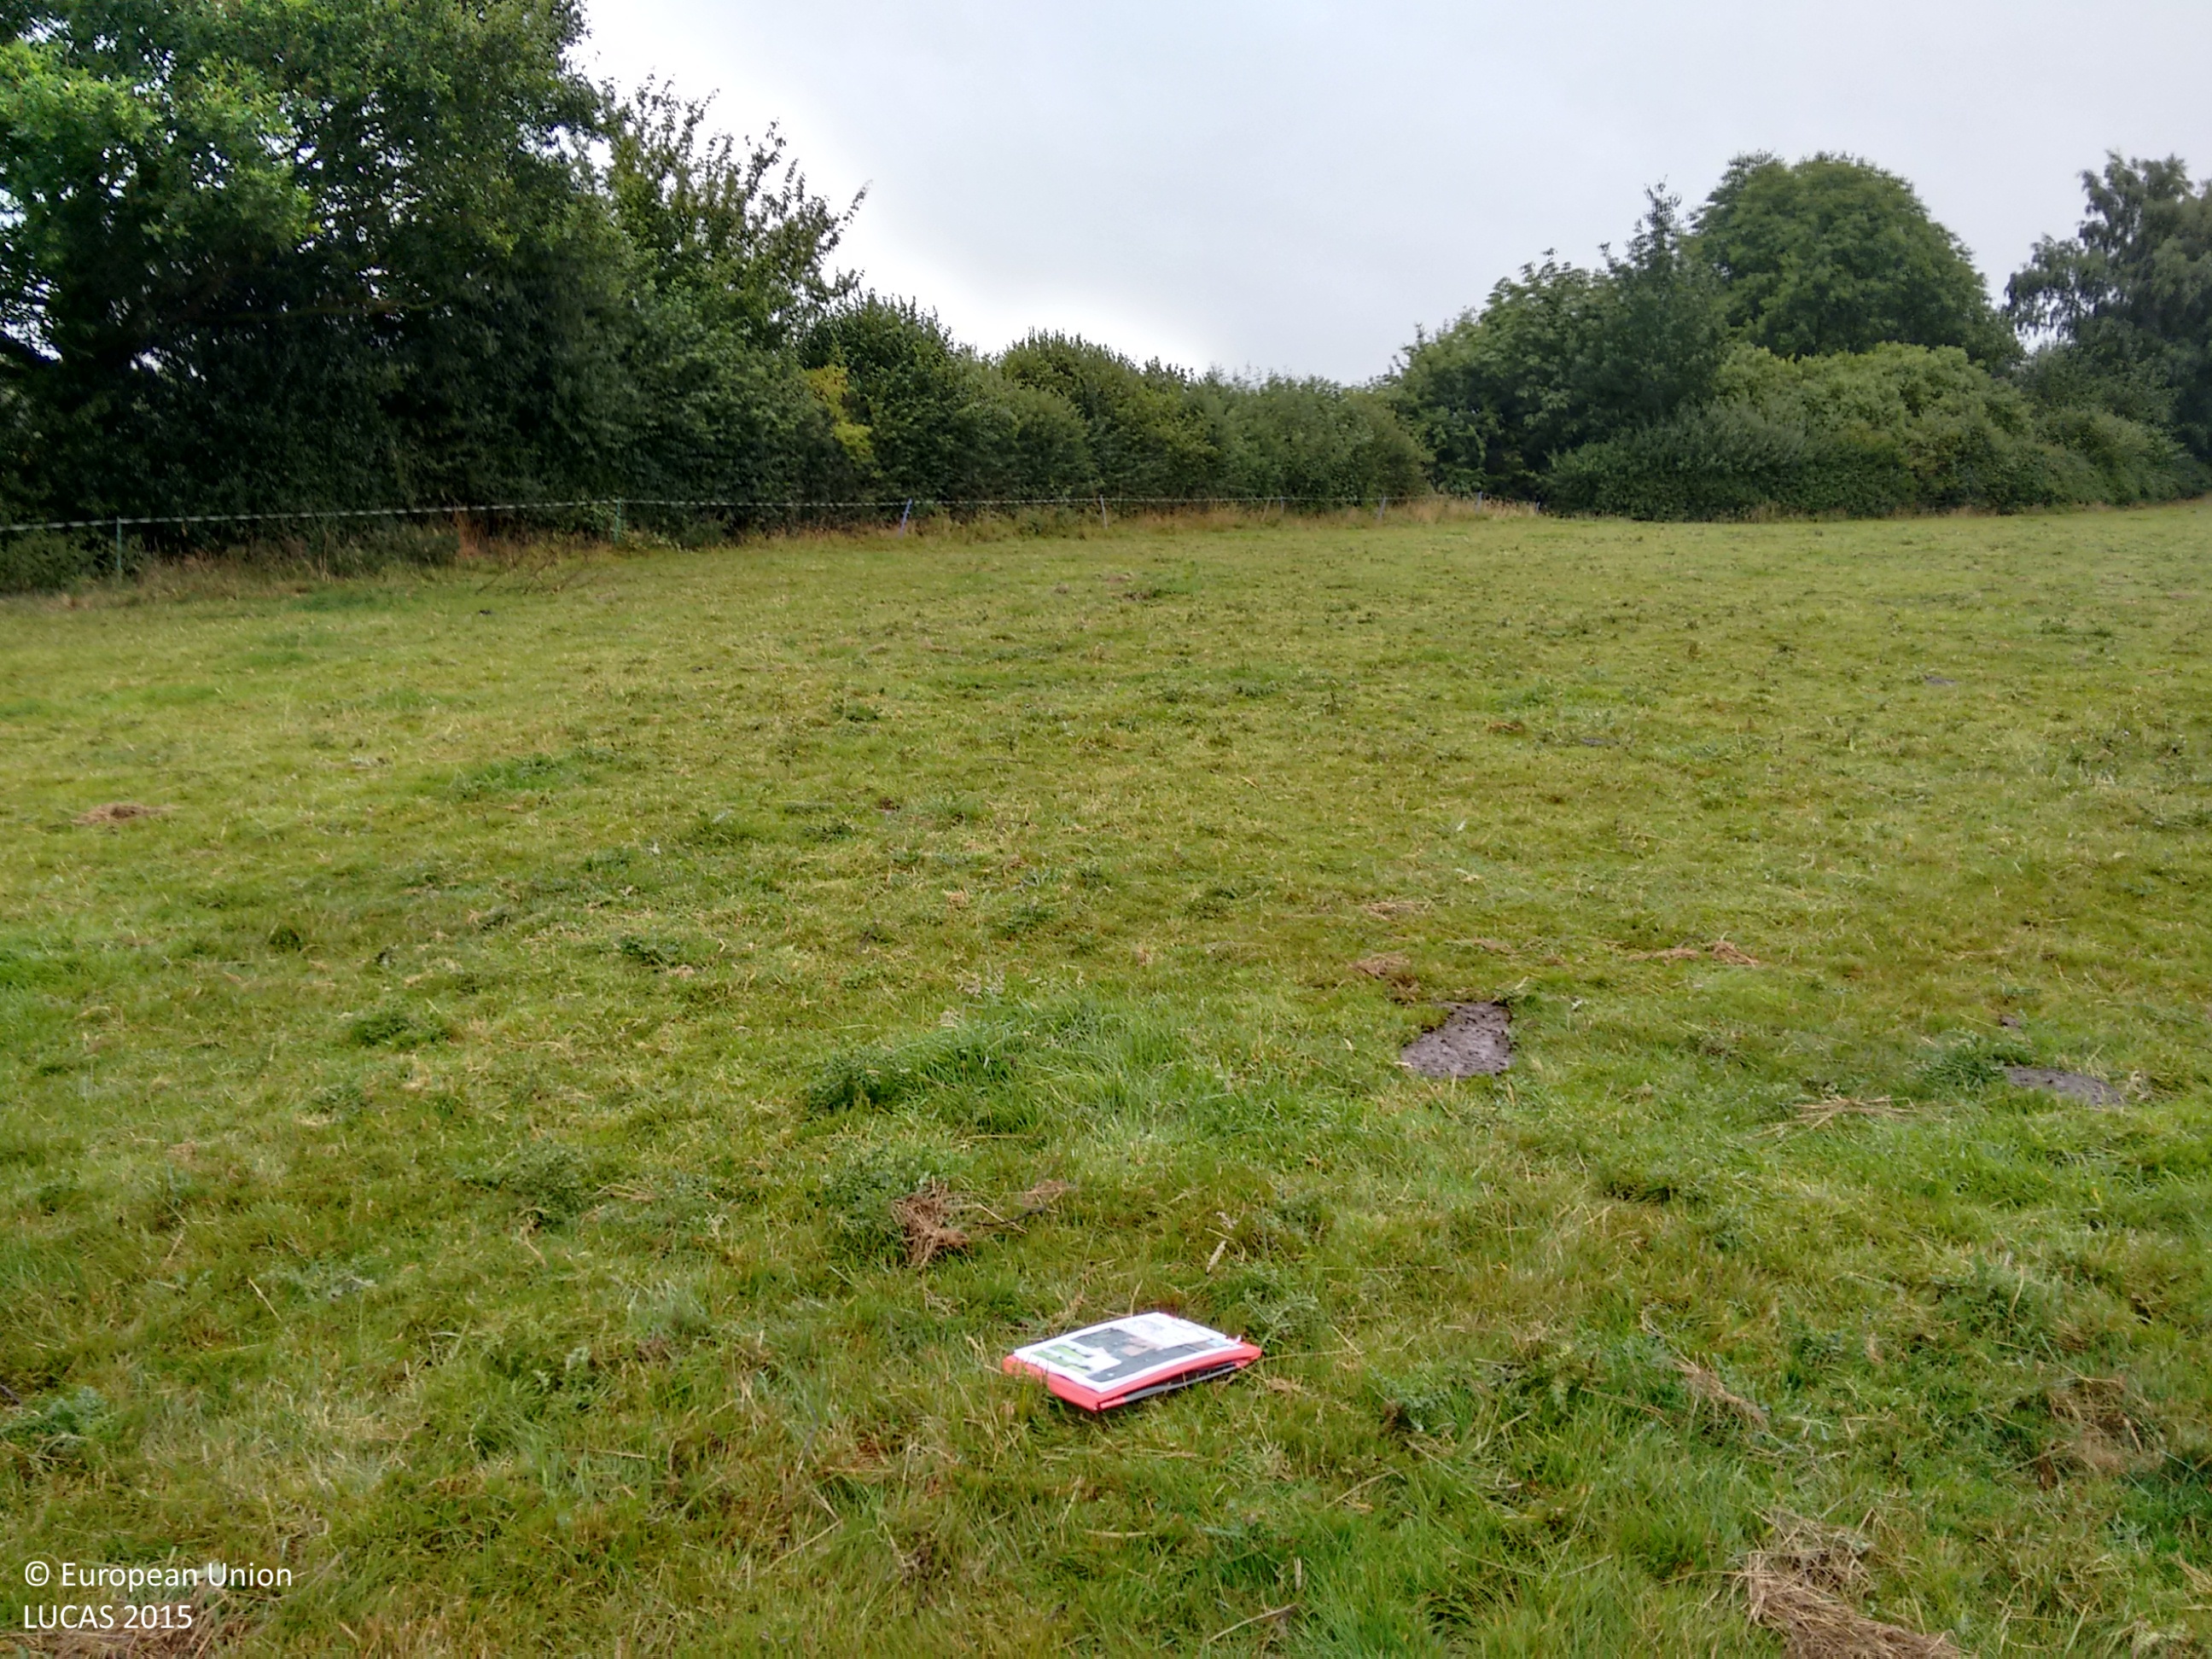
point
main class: Grassland
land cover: Grassland without tree/shrub cover
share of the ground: > 75 %
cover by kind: herbaceous plants 100 %
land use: Agriculture (excluding fallow land and kitchen gardens)
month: August
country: GB
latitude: 52.6273
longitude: -1.3805
